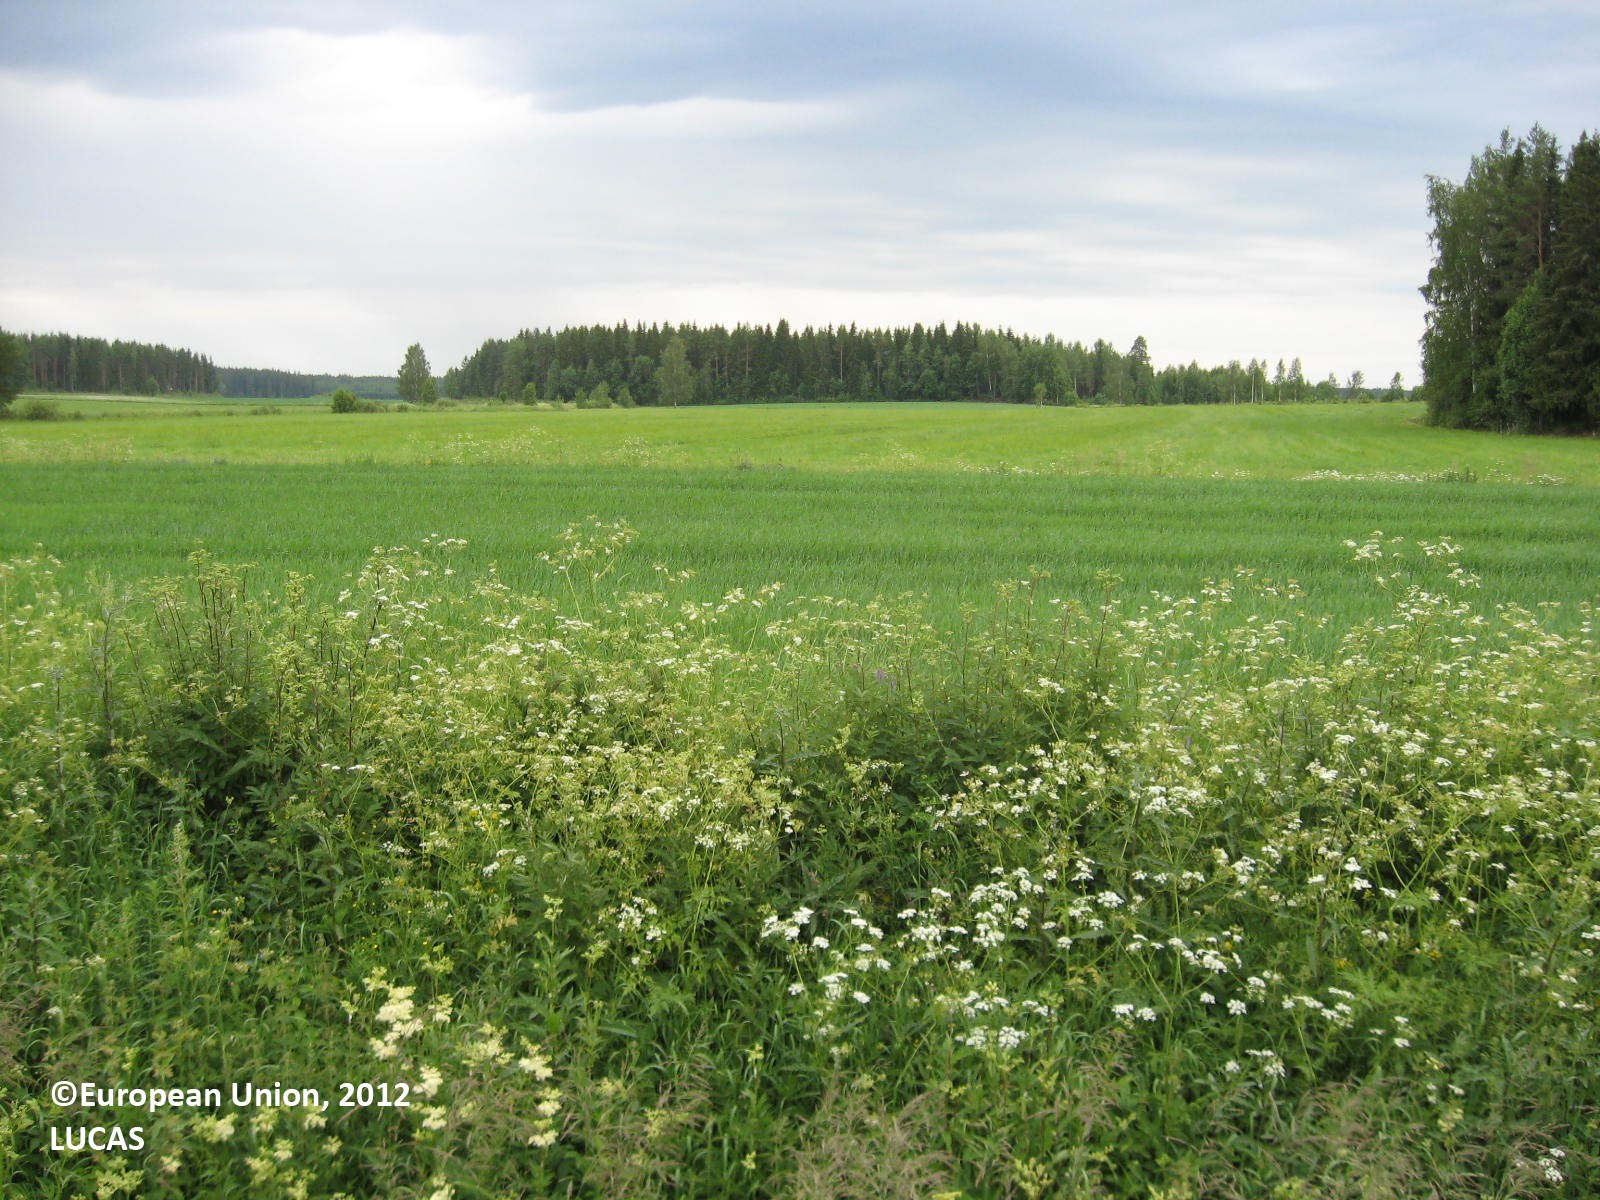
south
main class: Cropland
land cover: Rye
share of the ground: > 75 %
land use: Agriculture (excluding fallow land and kitchen gardens)
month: July
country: FI
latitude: 62.4773
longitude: 22.8834
